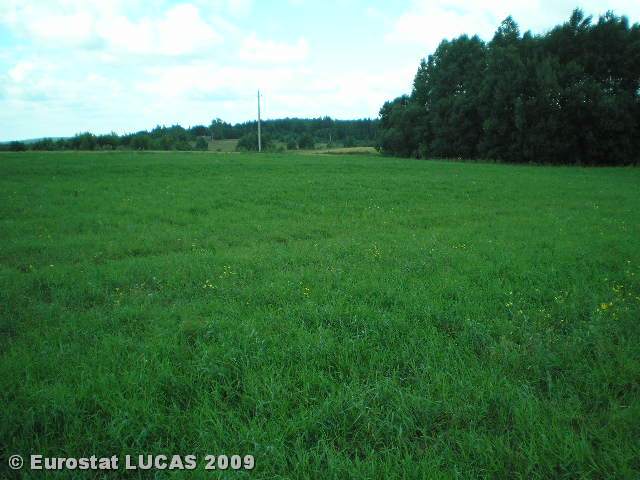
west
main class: Grassland
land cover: Grassland without tree/shrub cover
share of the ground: > 75 %
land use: Agriculture (excluding fallow land and kitchen gardens)
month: July
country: LT
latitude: 54.9025
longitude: 25.3912
